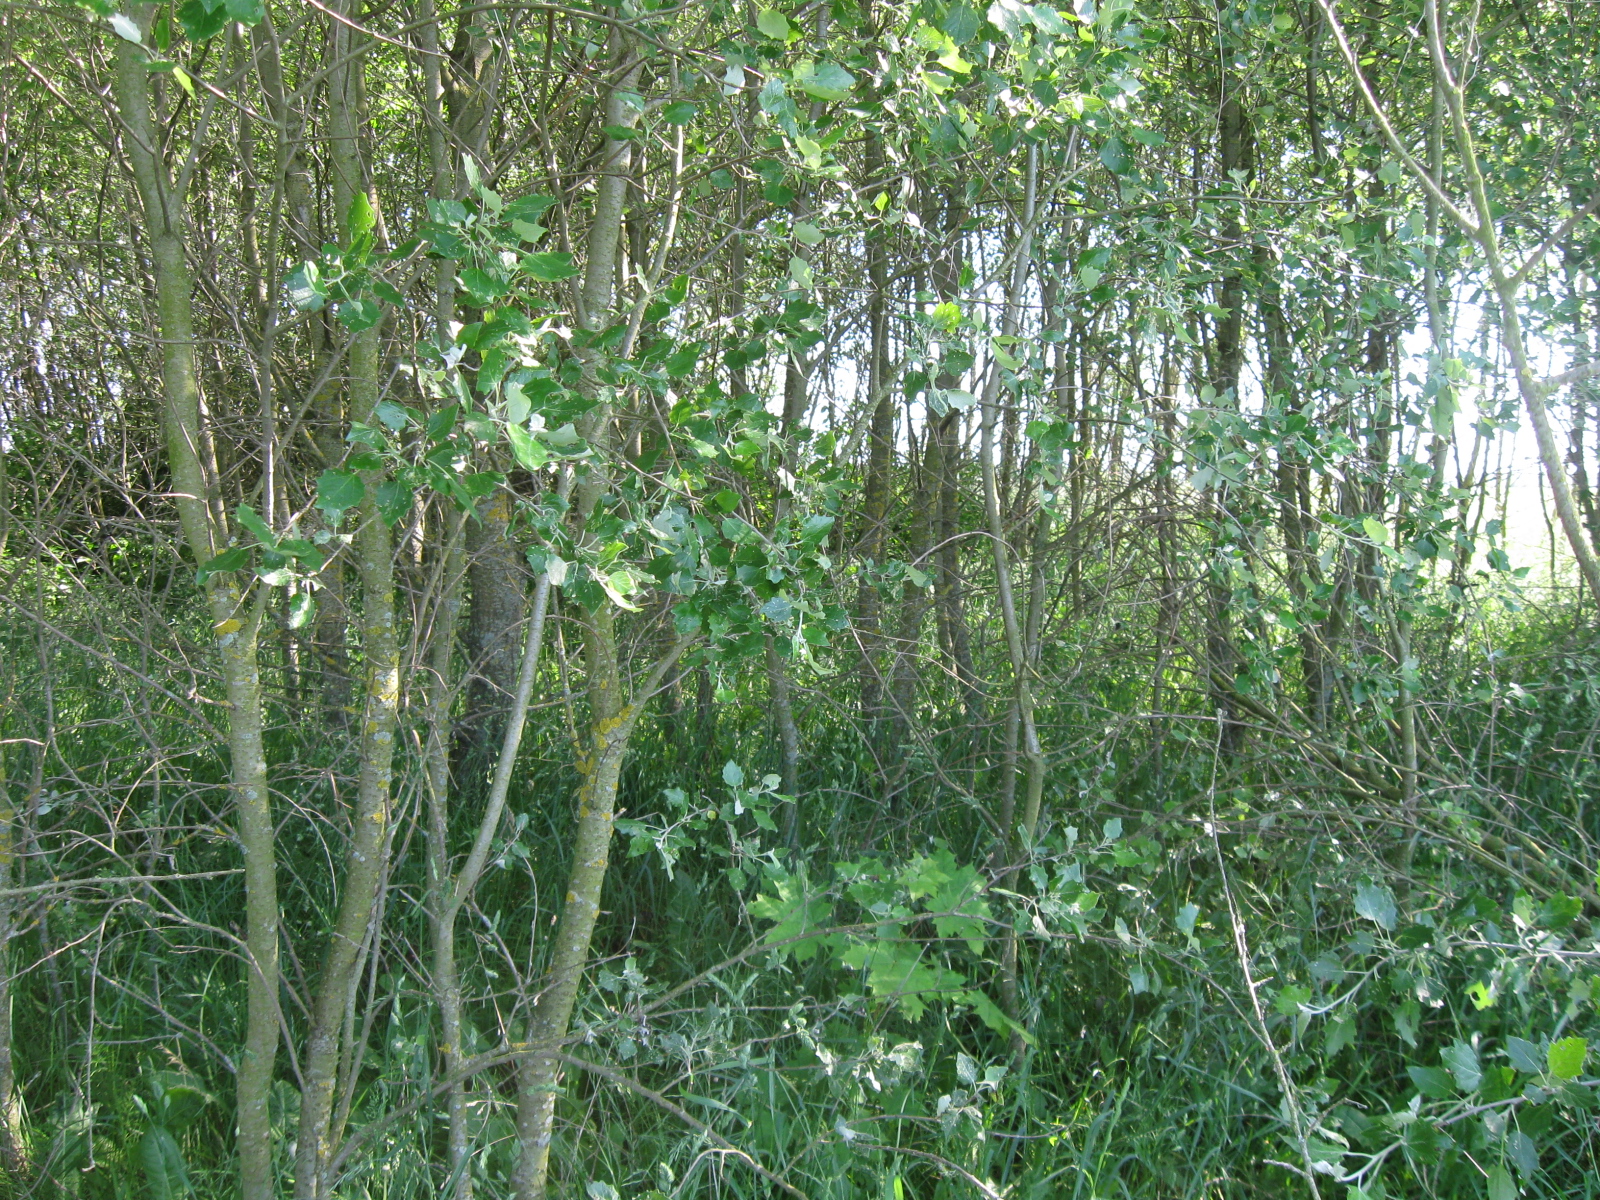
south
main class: Cropland
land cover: Common wheat
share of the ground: > 75 %
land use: Agriculture (excluding fallow land and kitchen gardens)
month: June
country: LT
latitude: 54.8168
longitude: 23.9562
